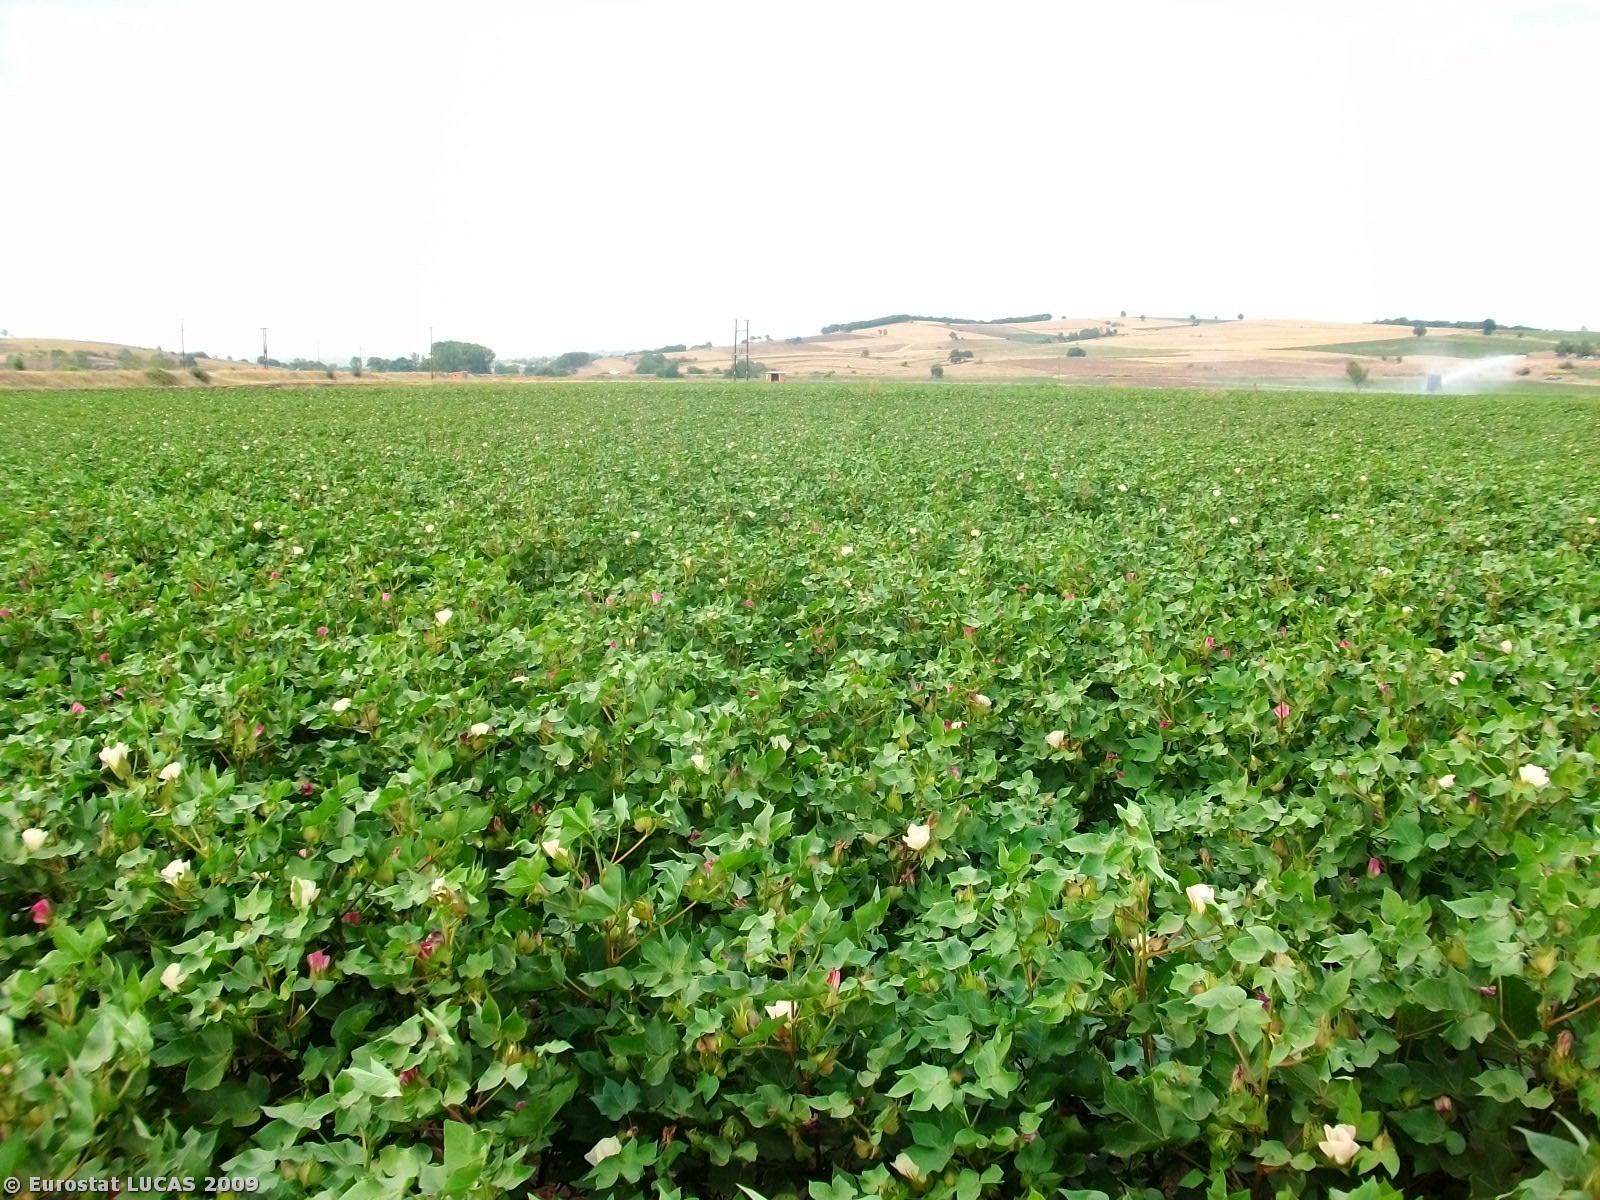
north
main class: Cropland
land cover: Cotton
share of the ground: > 75 %
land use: Agriculture (excluding fallow land and kitchen gardens)
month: August
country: GR
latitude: 41.4276
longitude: 26.3360
